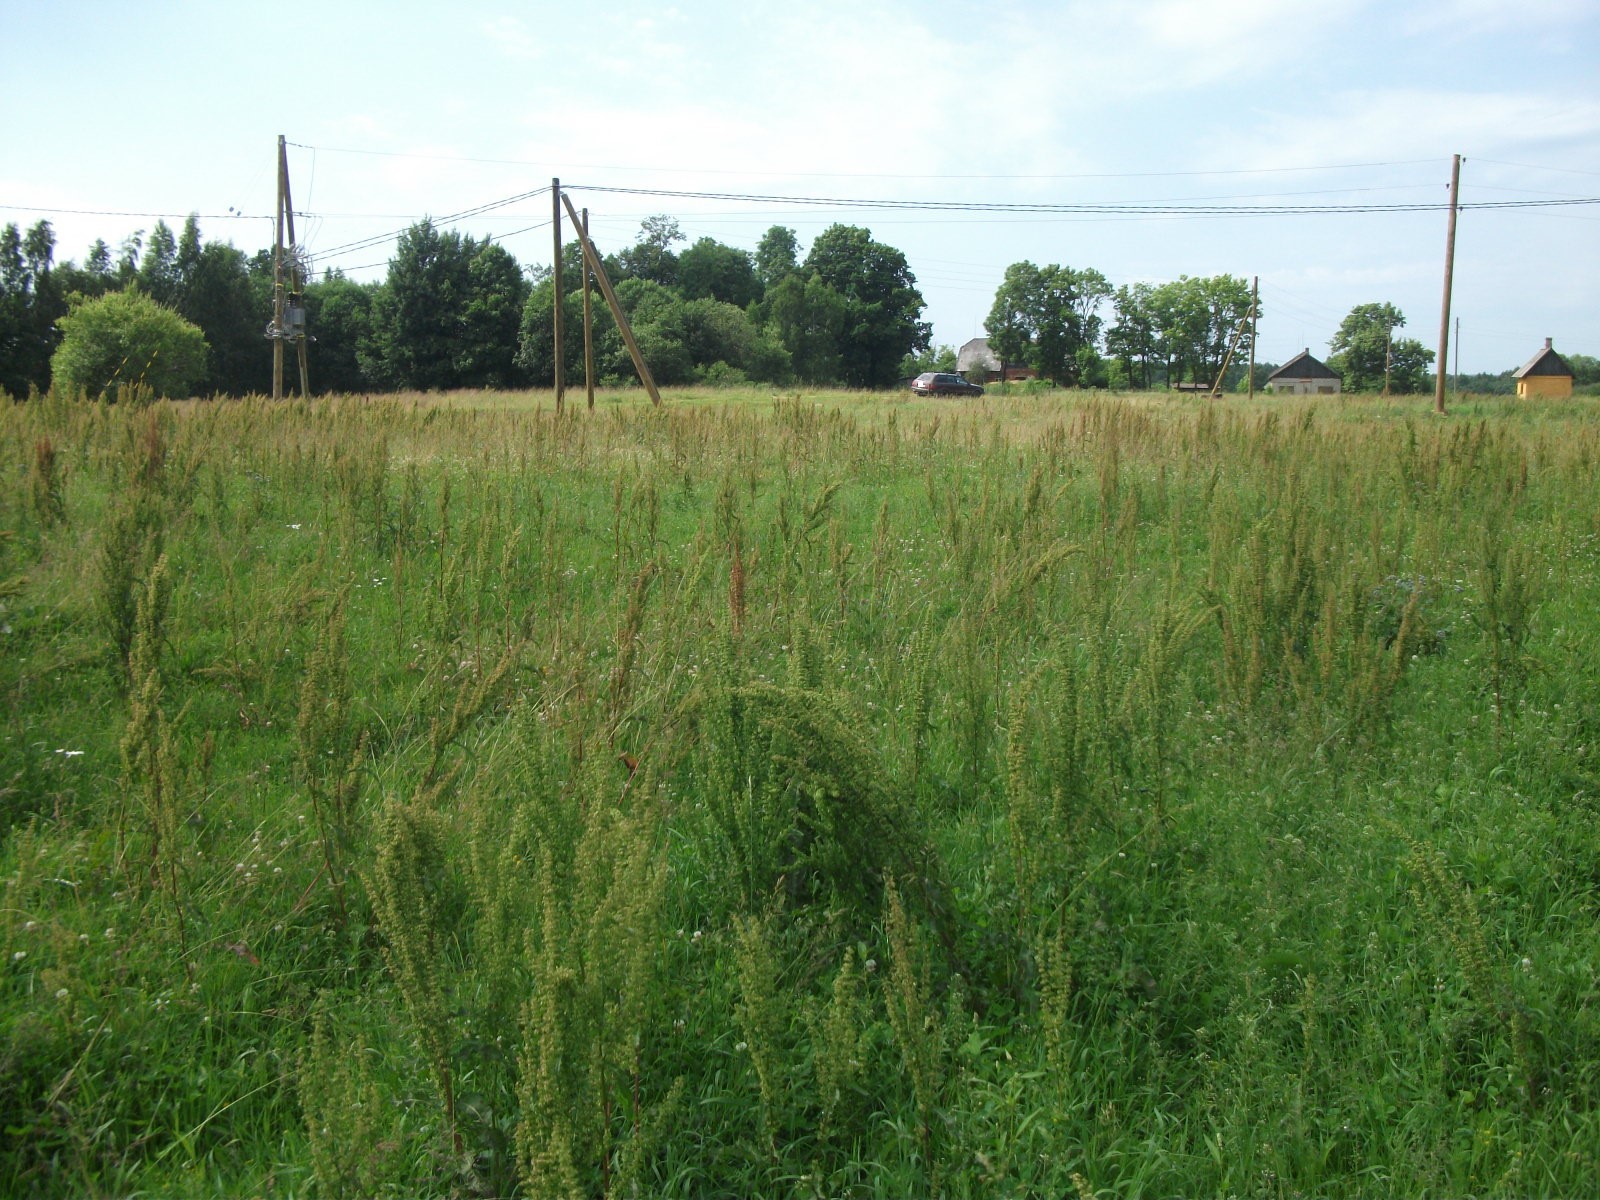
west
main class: Grassland
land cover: Grassland without tree/shrub cover
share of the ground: > 75 %
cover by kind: herbaceous plants 100 %
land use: Agriculture (excluding fallow land and kitchen gardens)
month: July
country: LV
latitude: 57.1485
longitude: 26.5251
